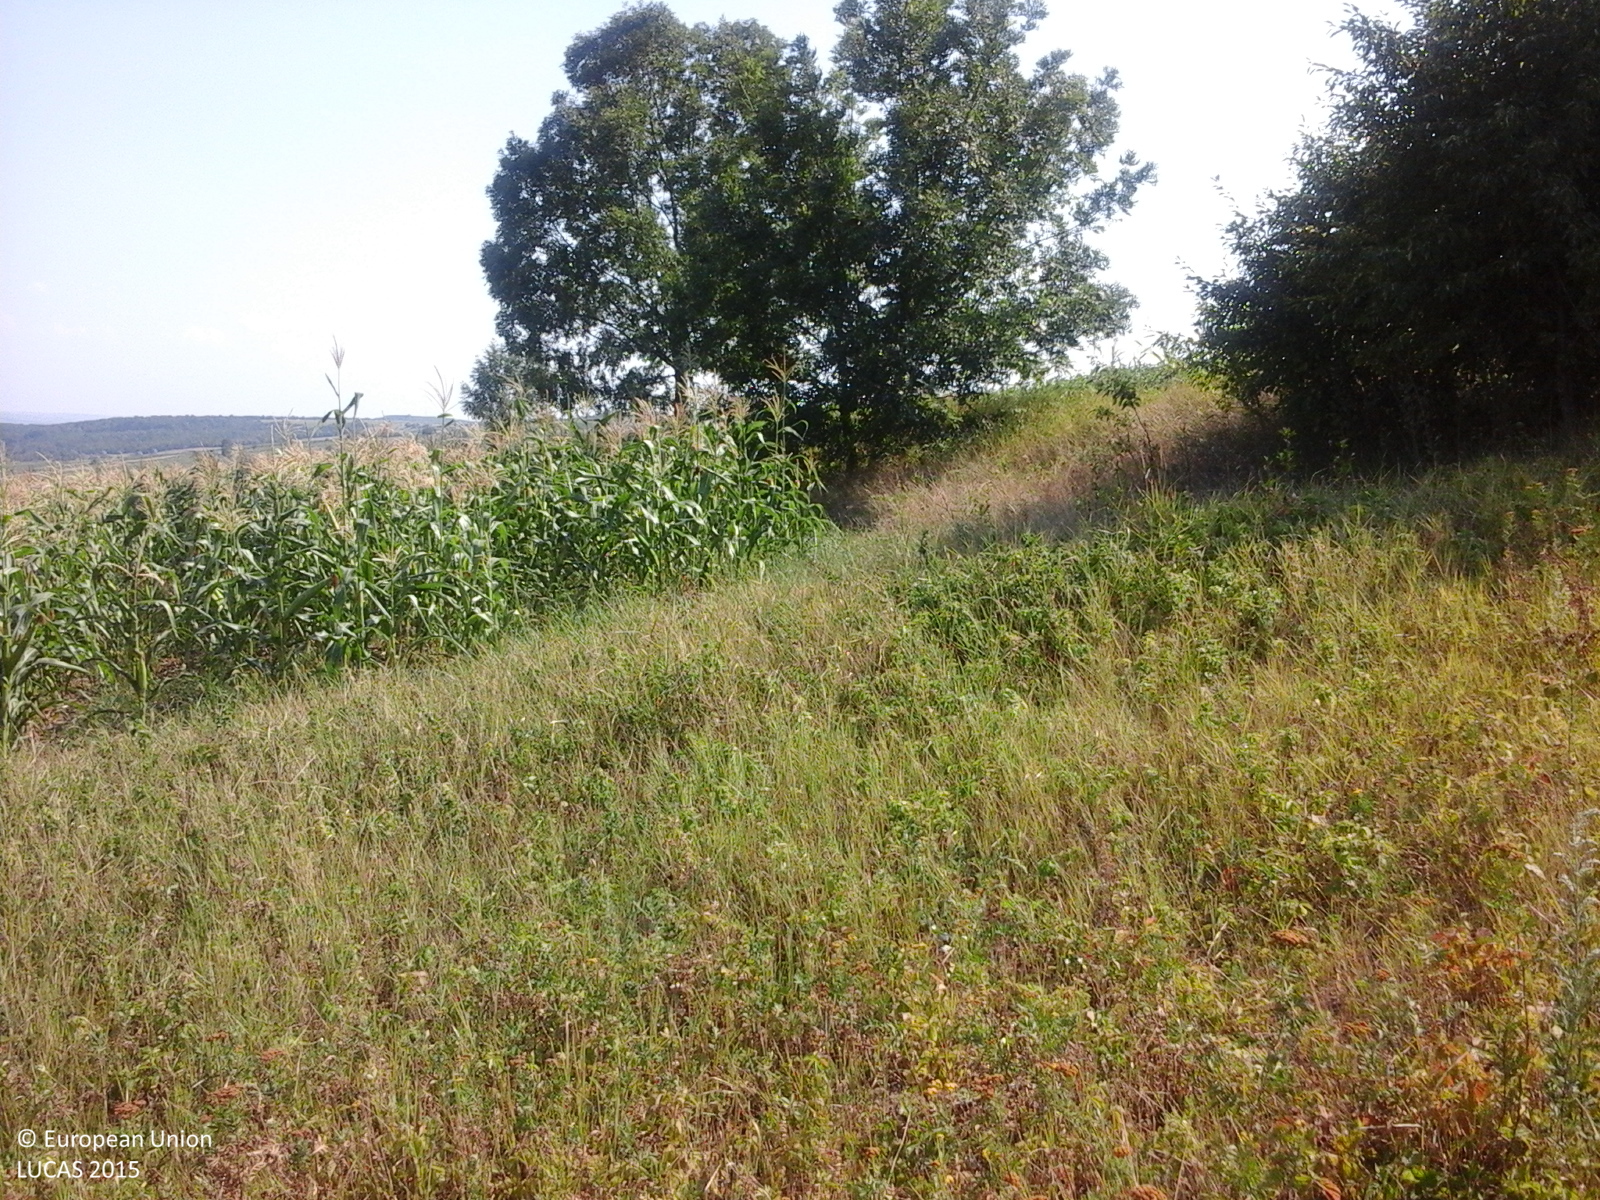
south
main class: Grassland
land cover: Spontaneously vegetated surfaces
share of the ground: > 75 %
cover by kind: herbaceous plants 100 %
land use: Agriculture (excluding fallow land and kitchen gardens)
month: July
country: RO
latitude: 46.2635
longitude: 27.3469
